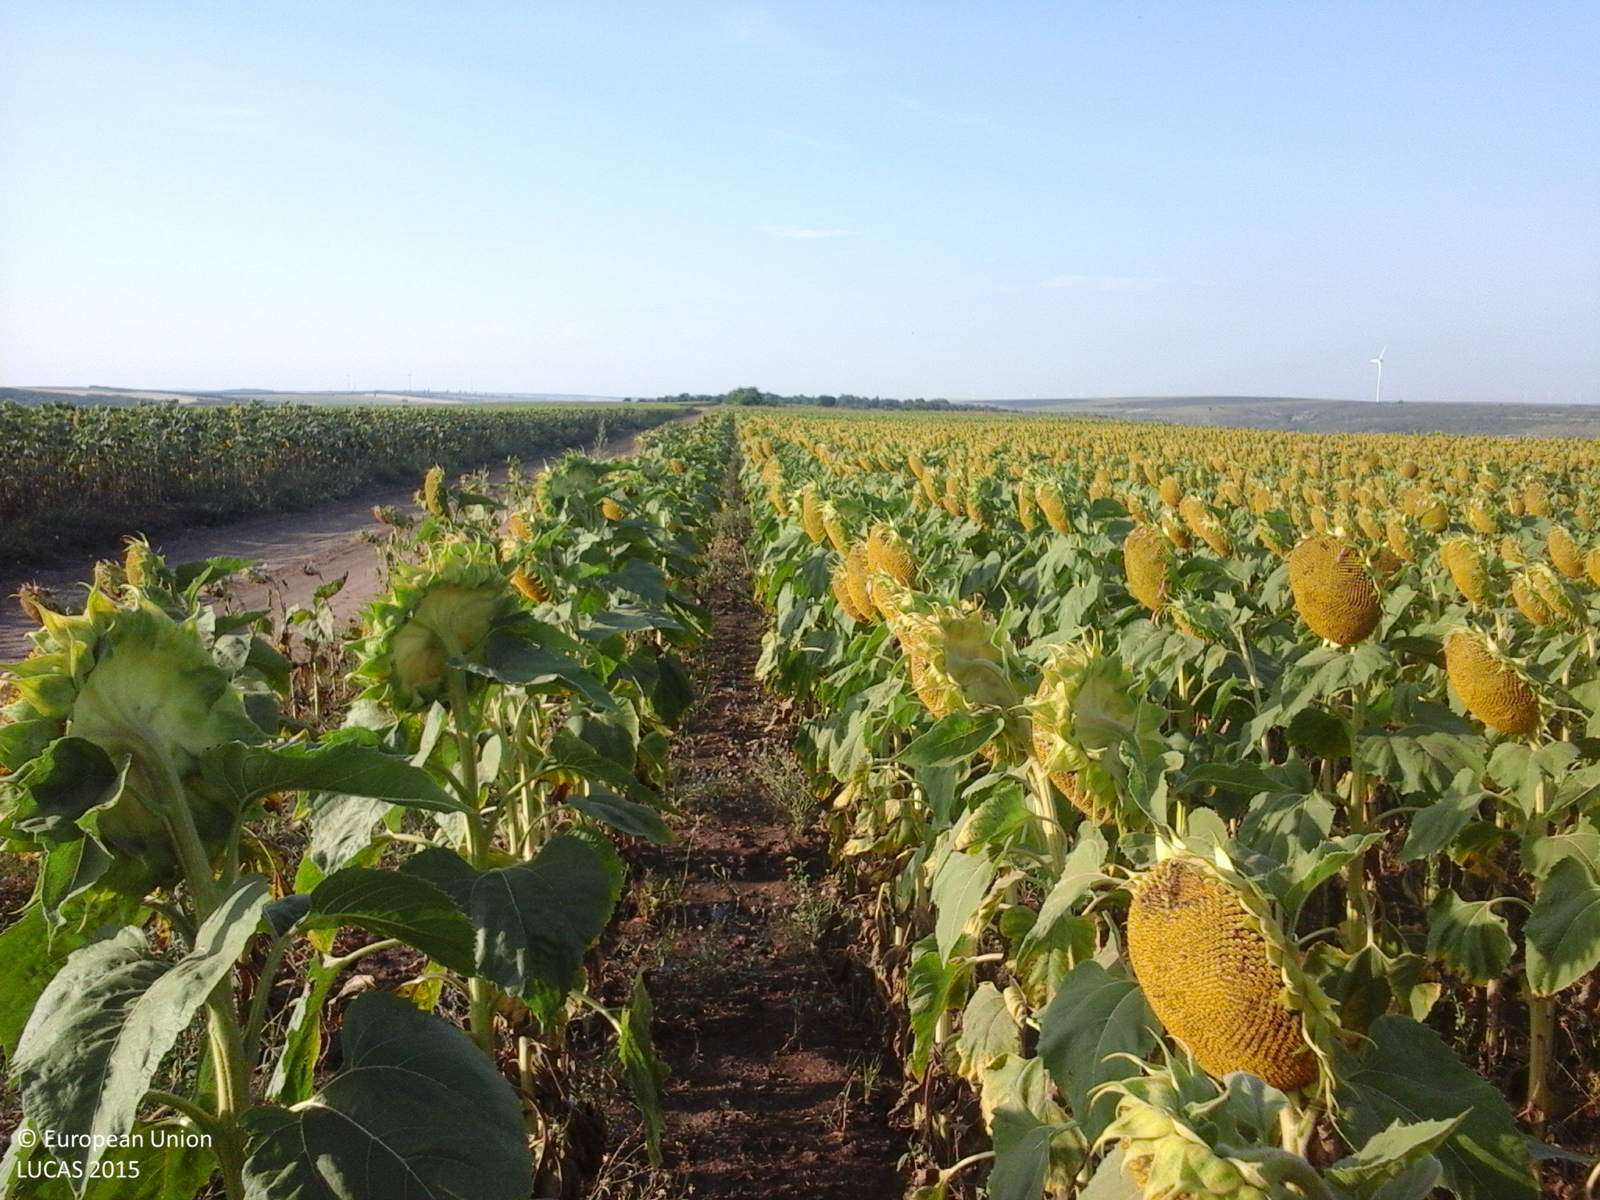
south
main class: Cropland
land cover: Sunflower
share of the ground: > 75 %
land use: Agriculture (excluding fallow land and kitchen gardens)
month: July
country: RO
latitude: 45.9654
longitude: 27.8077
